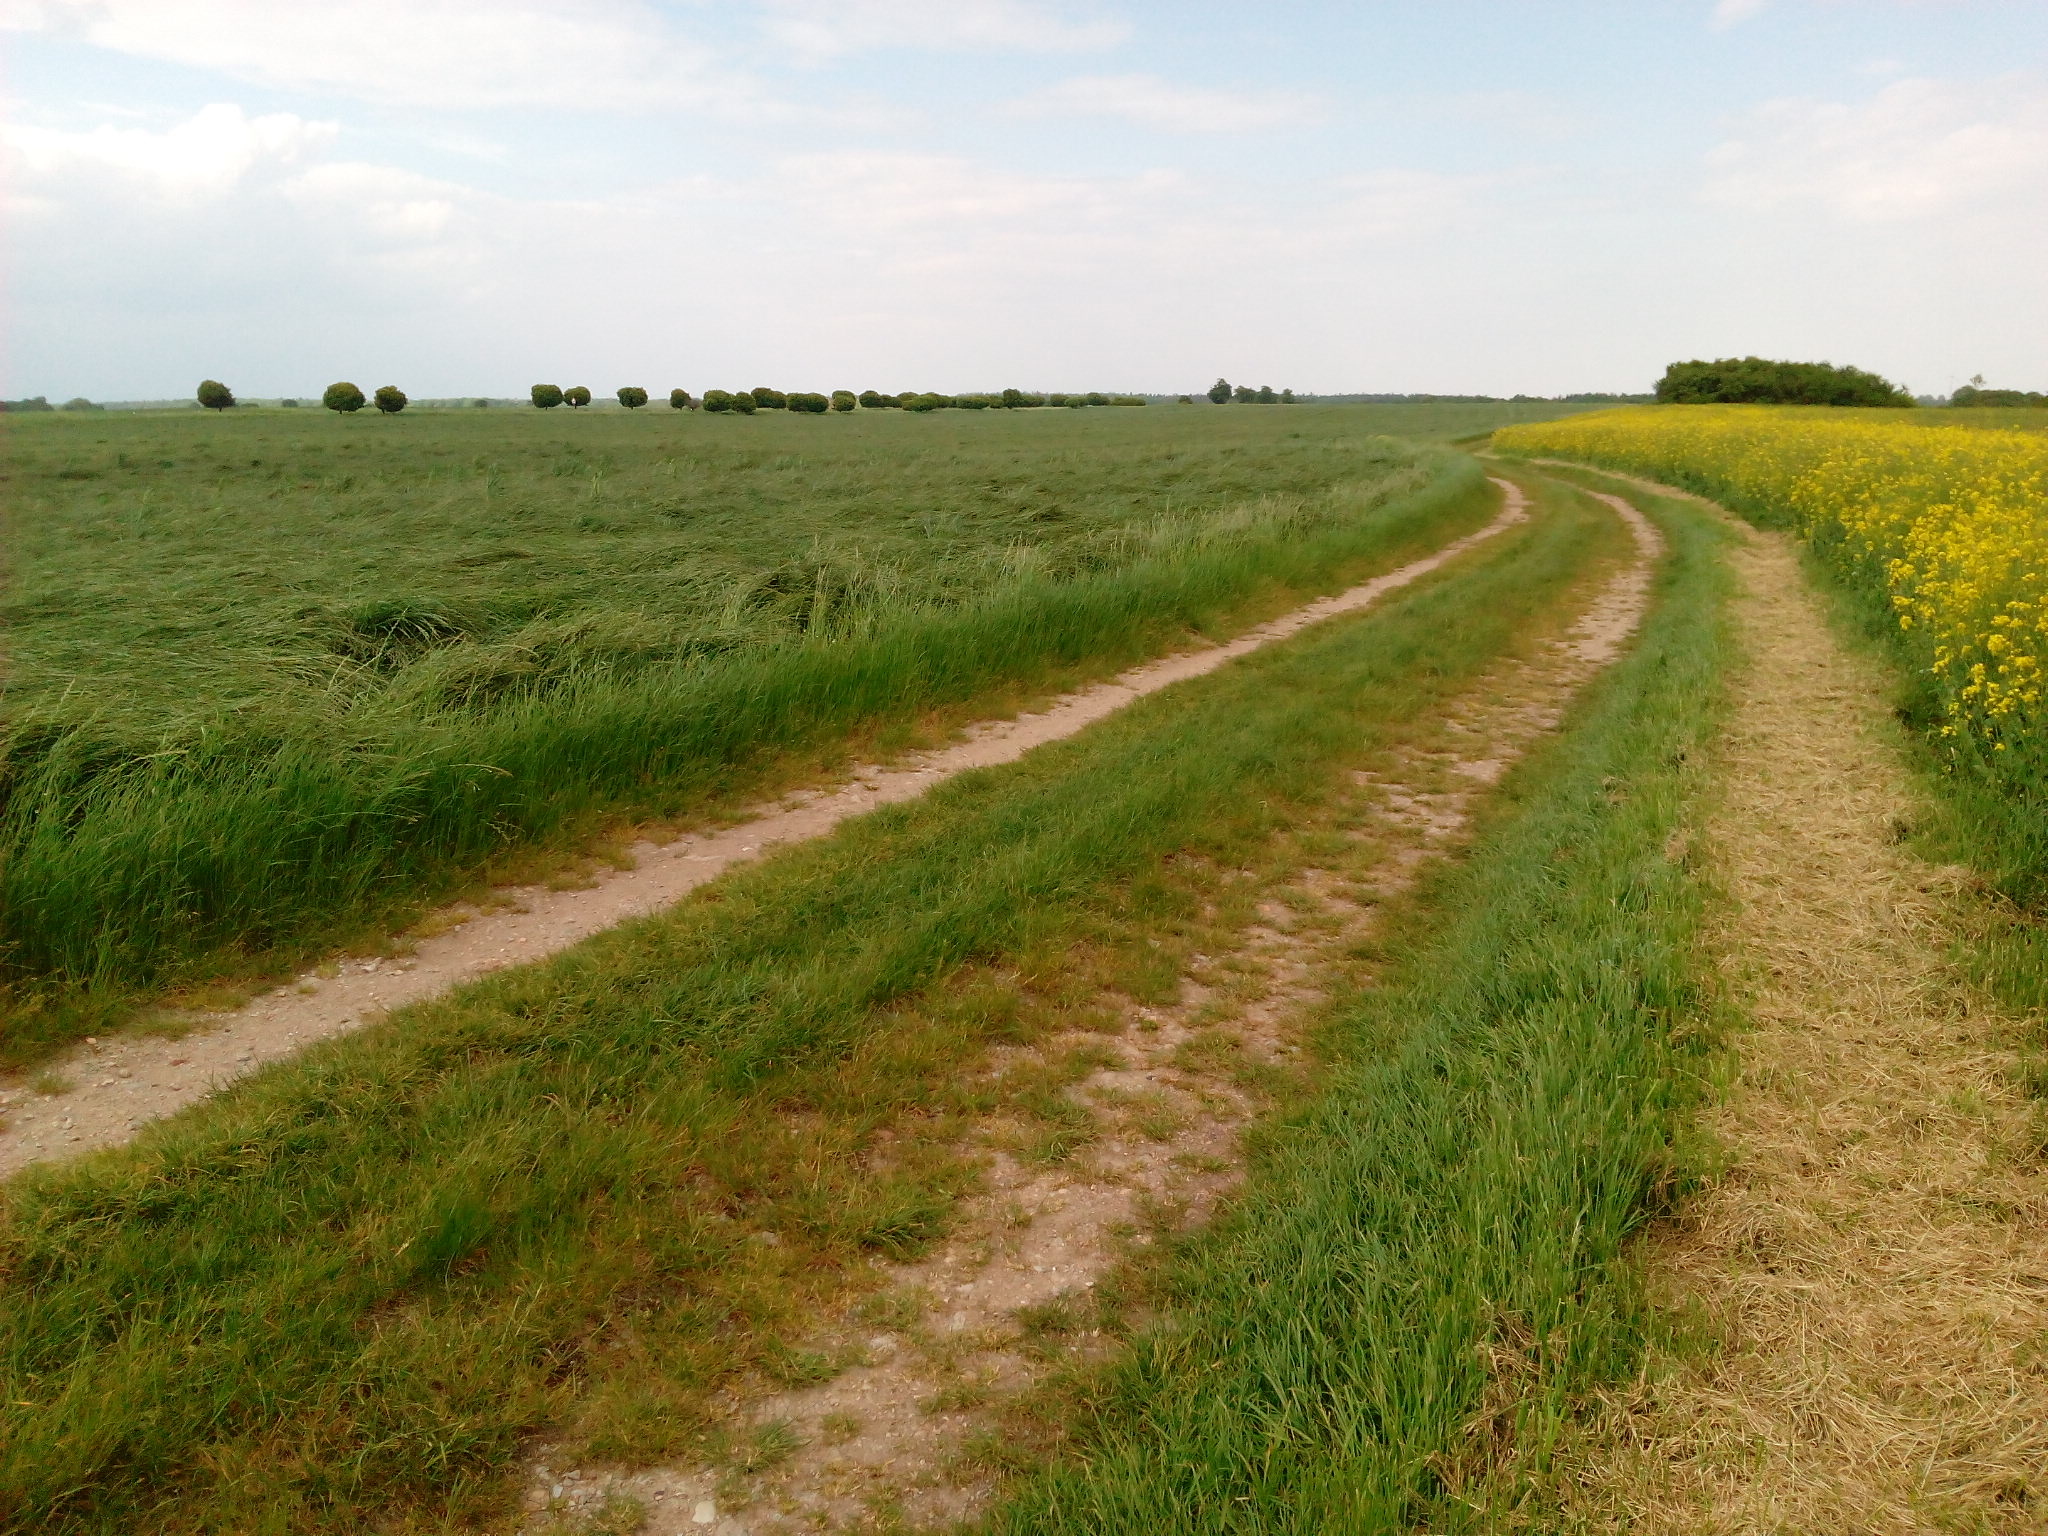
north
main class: Cropland
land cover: Rape and turnip rape
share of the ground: > 75 %
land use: Agriculture (excluding fallow land and kitchen gardens)
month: May
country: DE
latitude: 53.7179
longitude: 13.2575
